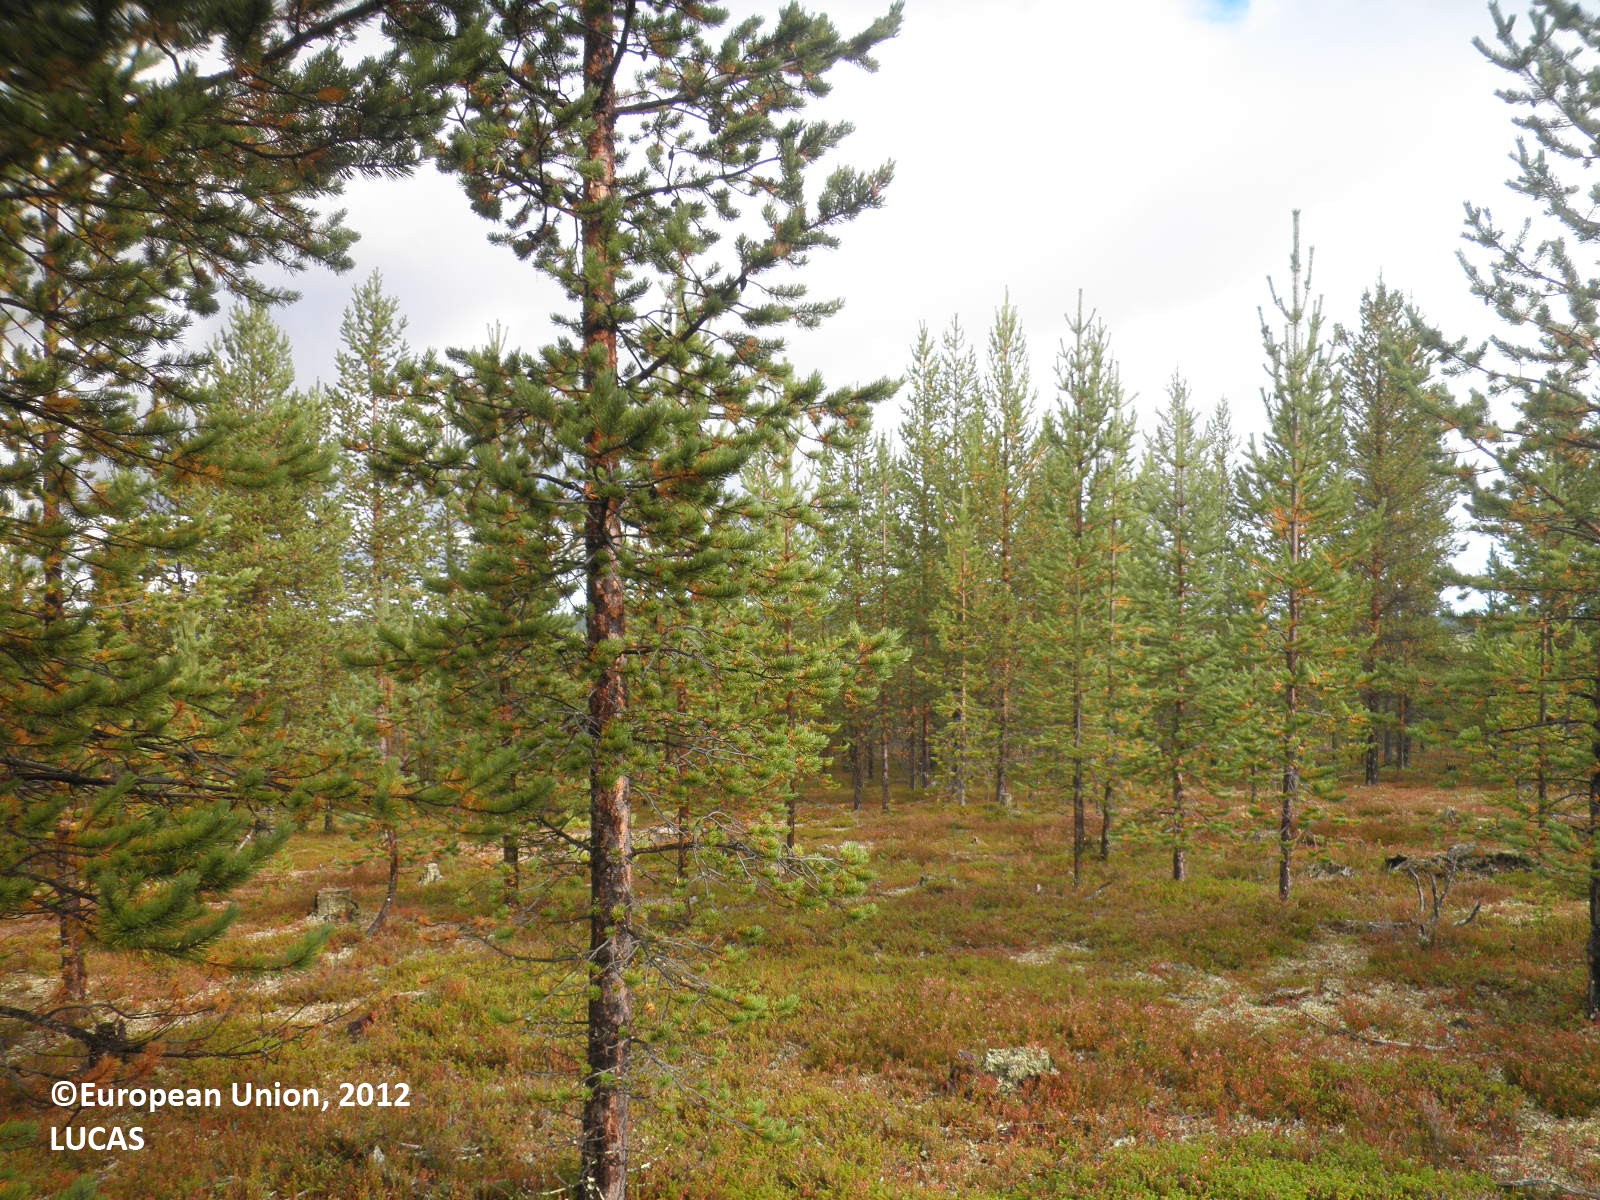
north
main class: Woodland
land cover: Pine dominated coniferous woodland
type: boreal forest
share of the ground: 10 - 25 %
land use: Forestry
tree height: > 5 m
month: September
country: FI
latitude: 67.4622
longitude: 28.3846
